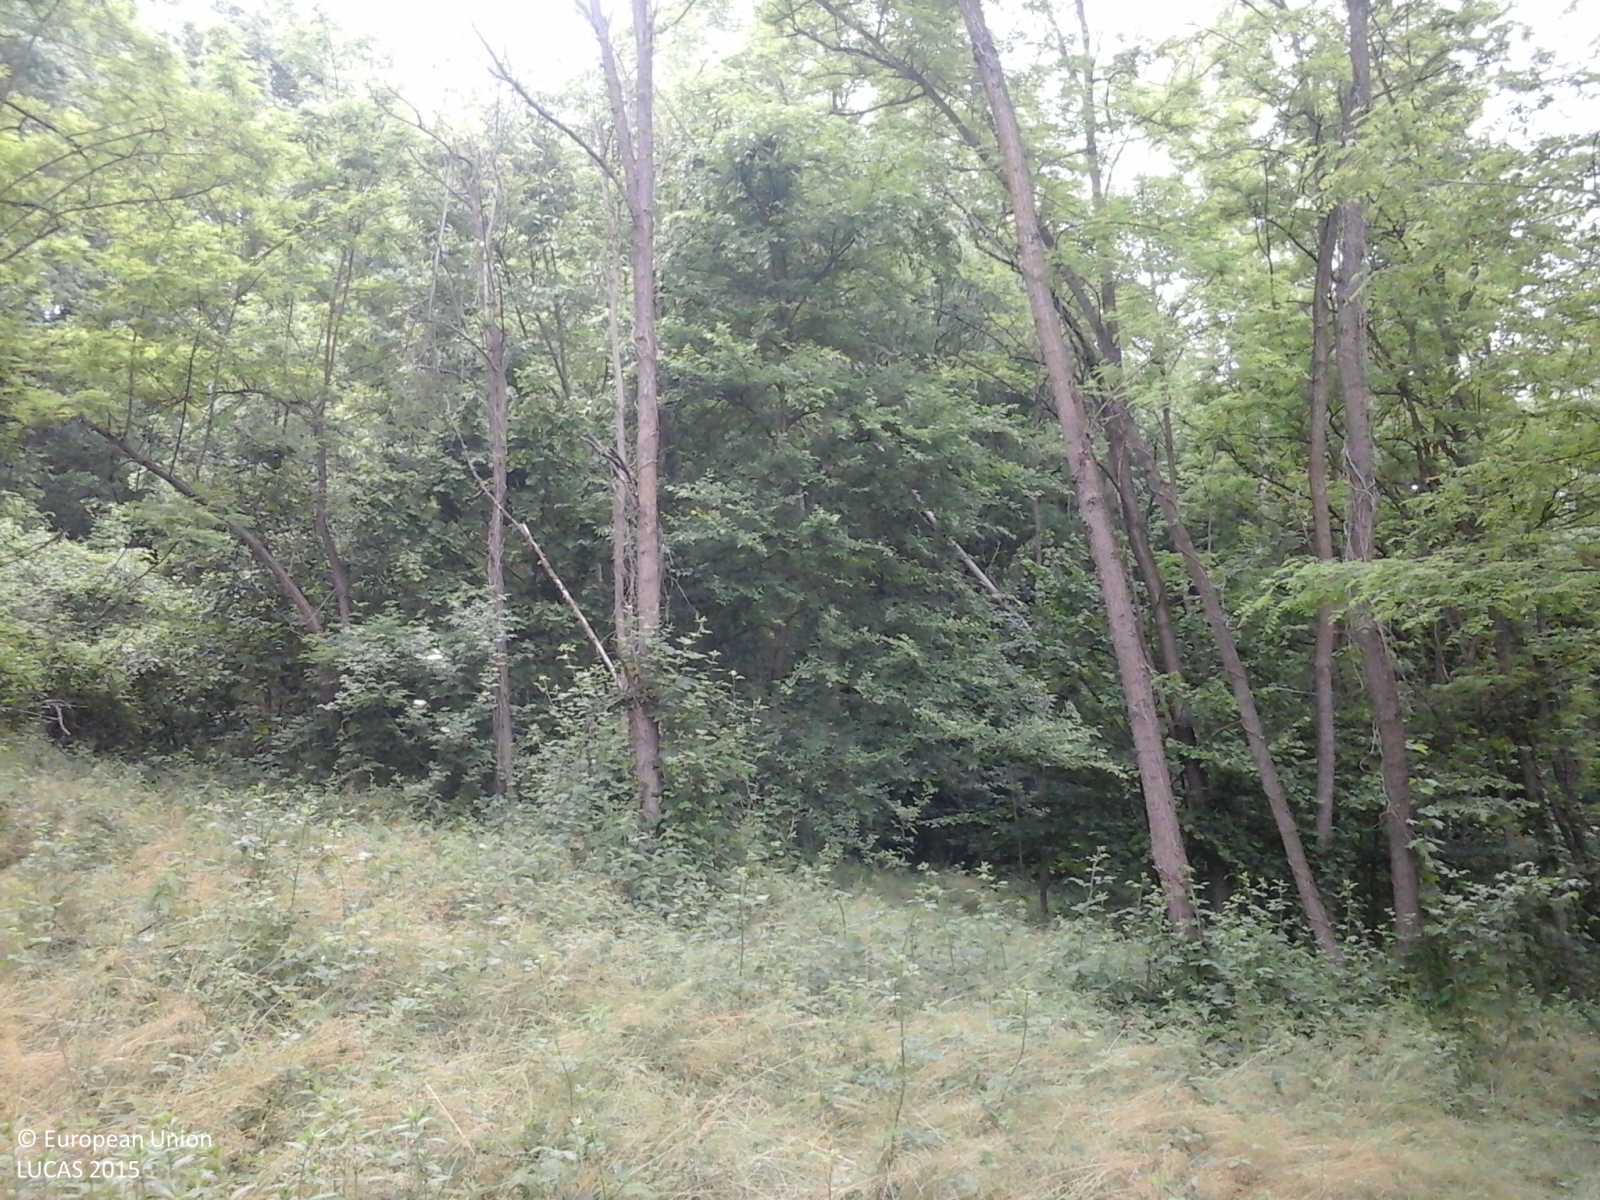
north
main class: Woodland
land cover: Broadleaved woodland
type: thermophilous deciduous forest
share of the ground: > 75 %
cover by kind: broadleaved forest trees 85 %, shrubs 10 %, herbaceous plants 5 %
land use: Forestry
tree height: > 5 m
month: May
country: IT
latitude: 44.8420
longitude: 8.3207
